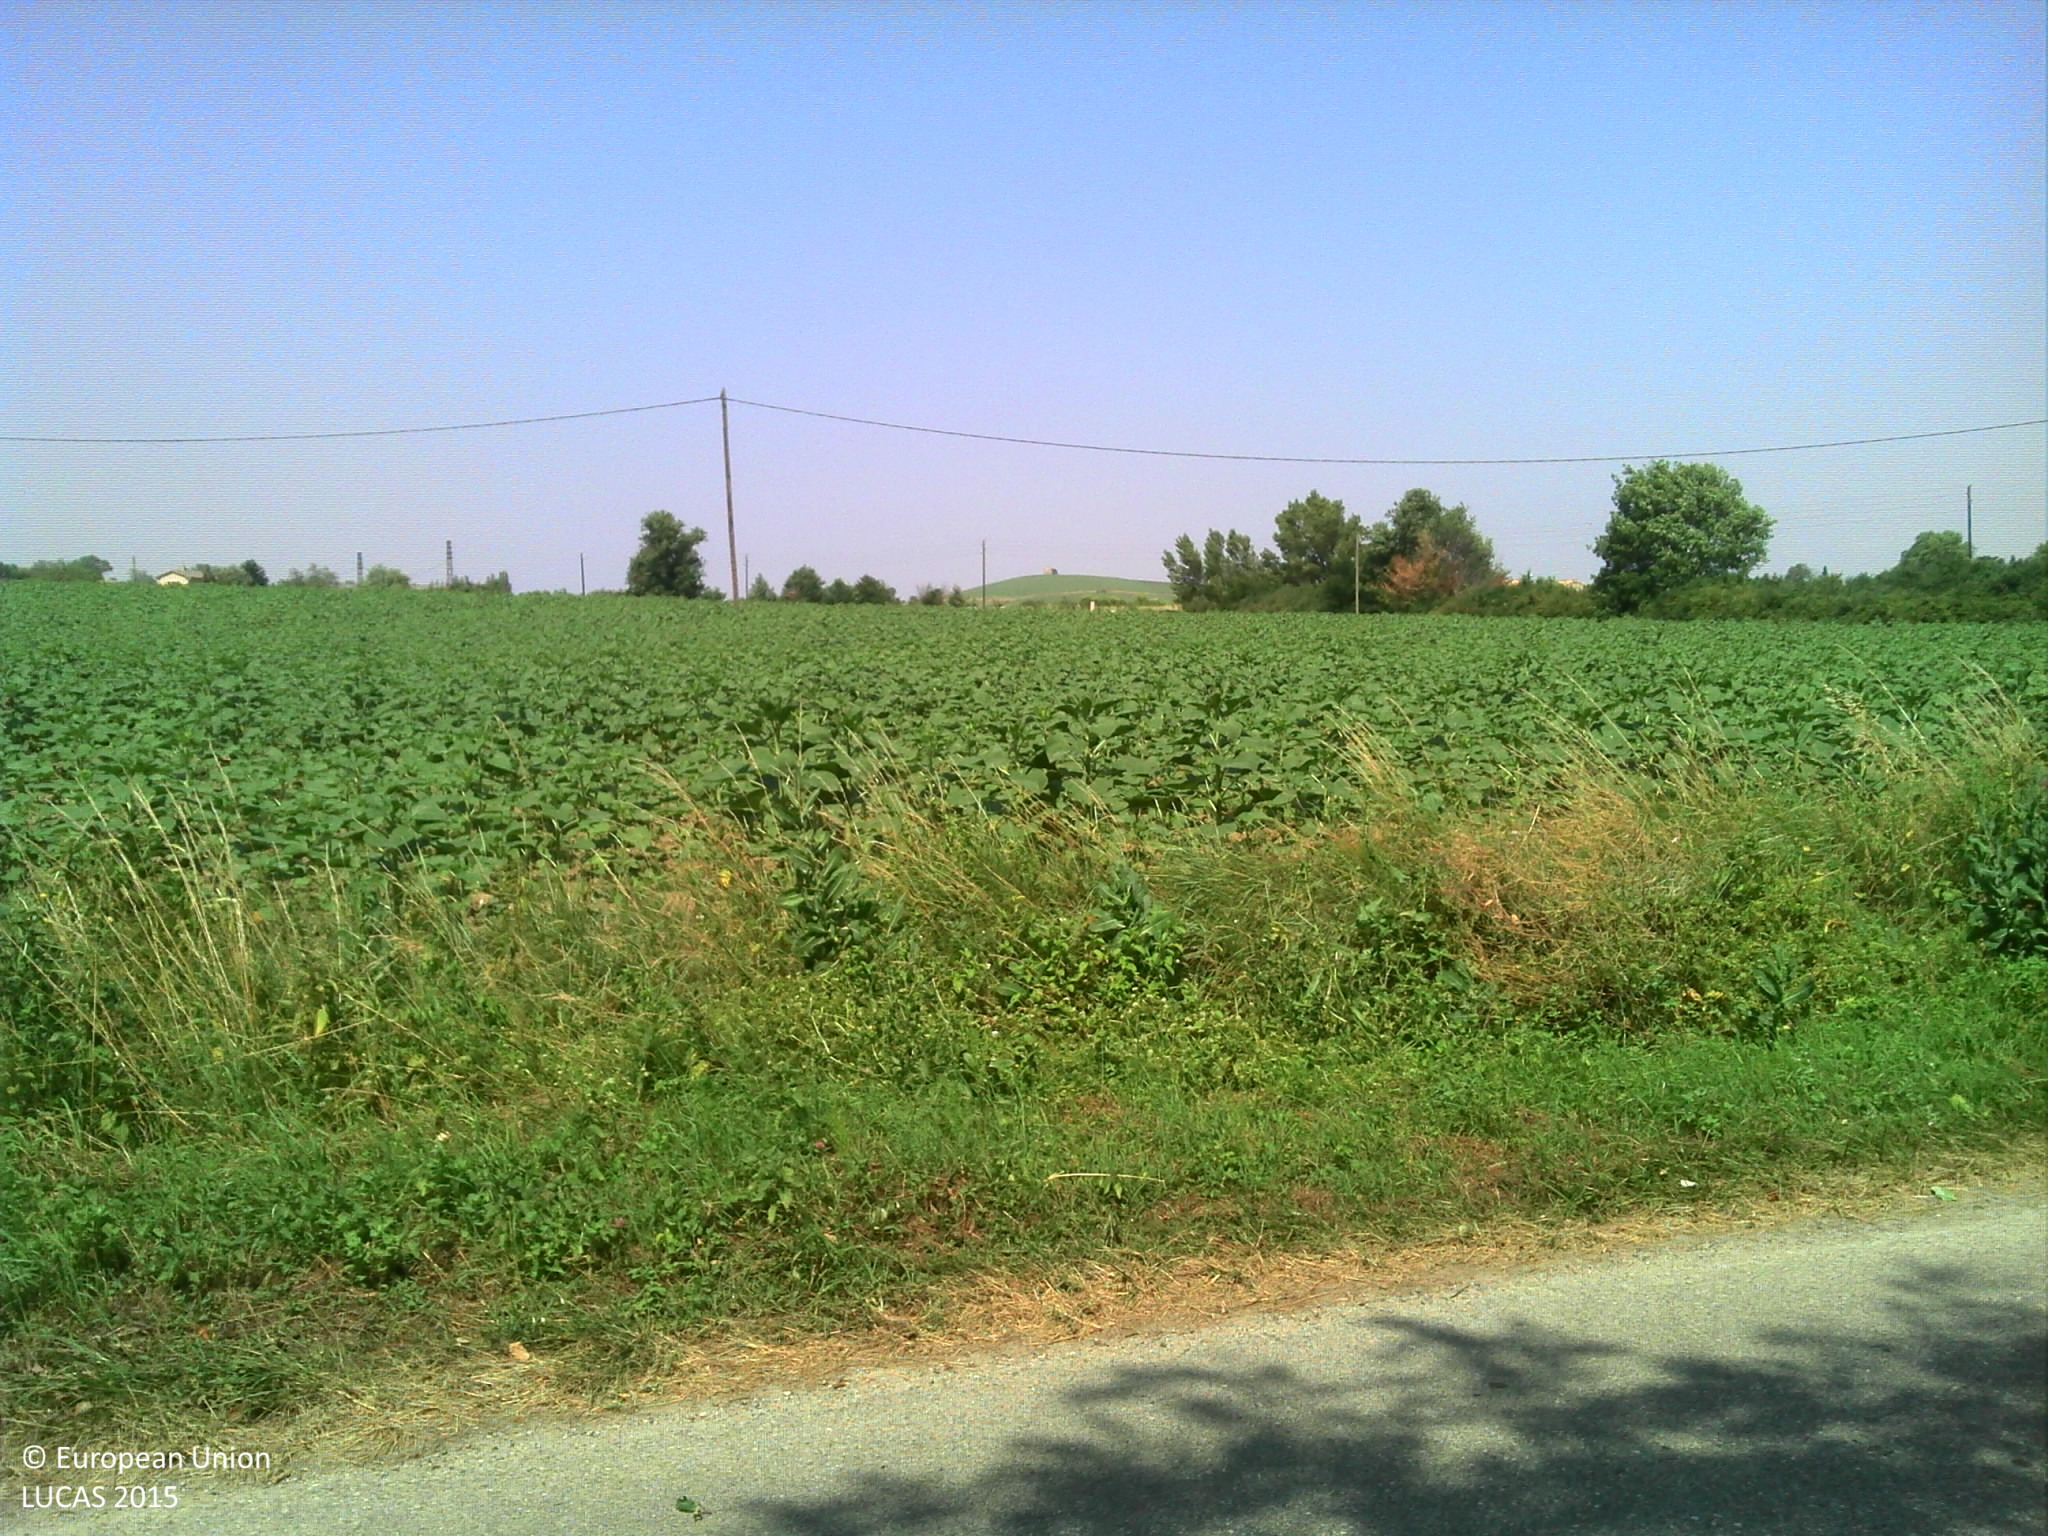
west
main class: Woodland
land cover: Pine dominated mixed woodland
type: thermophilous deciduous forest
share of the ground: > 75 %
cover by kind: broadleaved forest trees 75 %, coniferous forest trees 25 %
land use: Residential
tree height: > 5 m
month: July
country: FR
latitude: 43.1450
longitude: 2.1262
